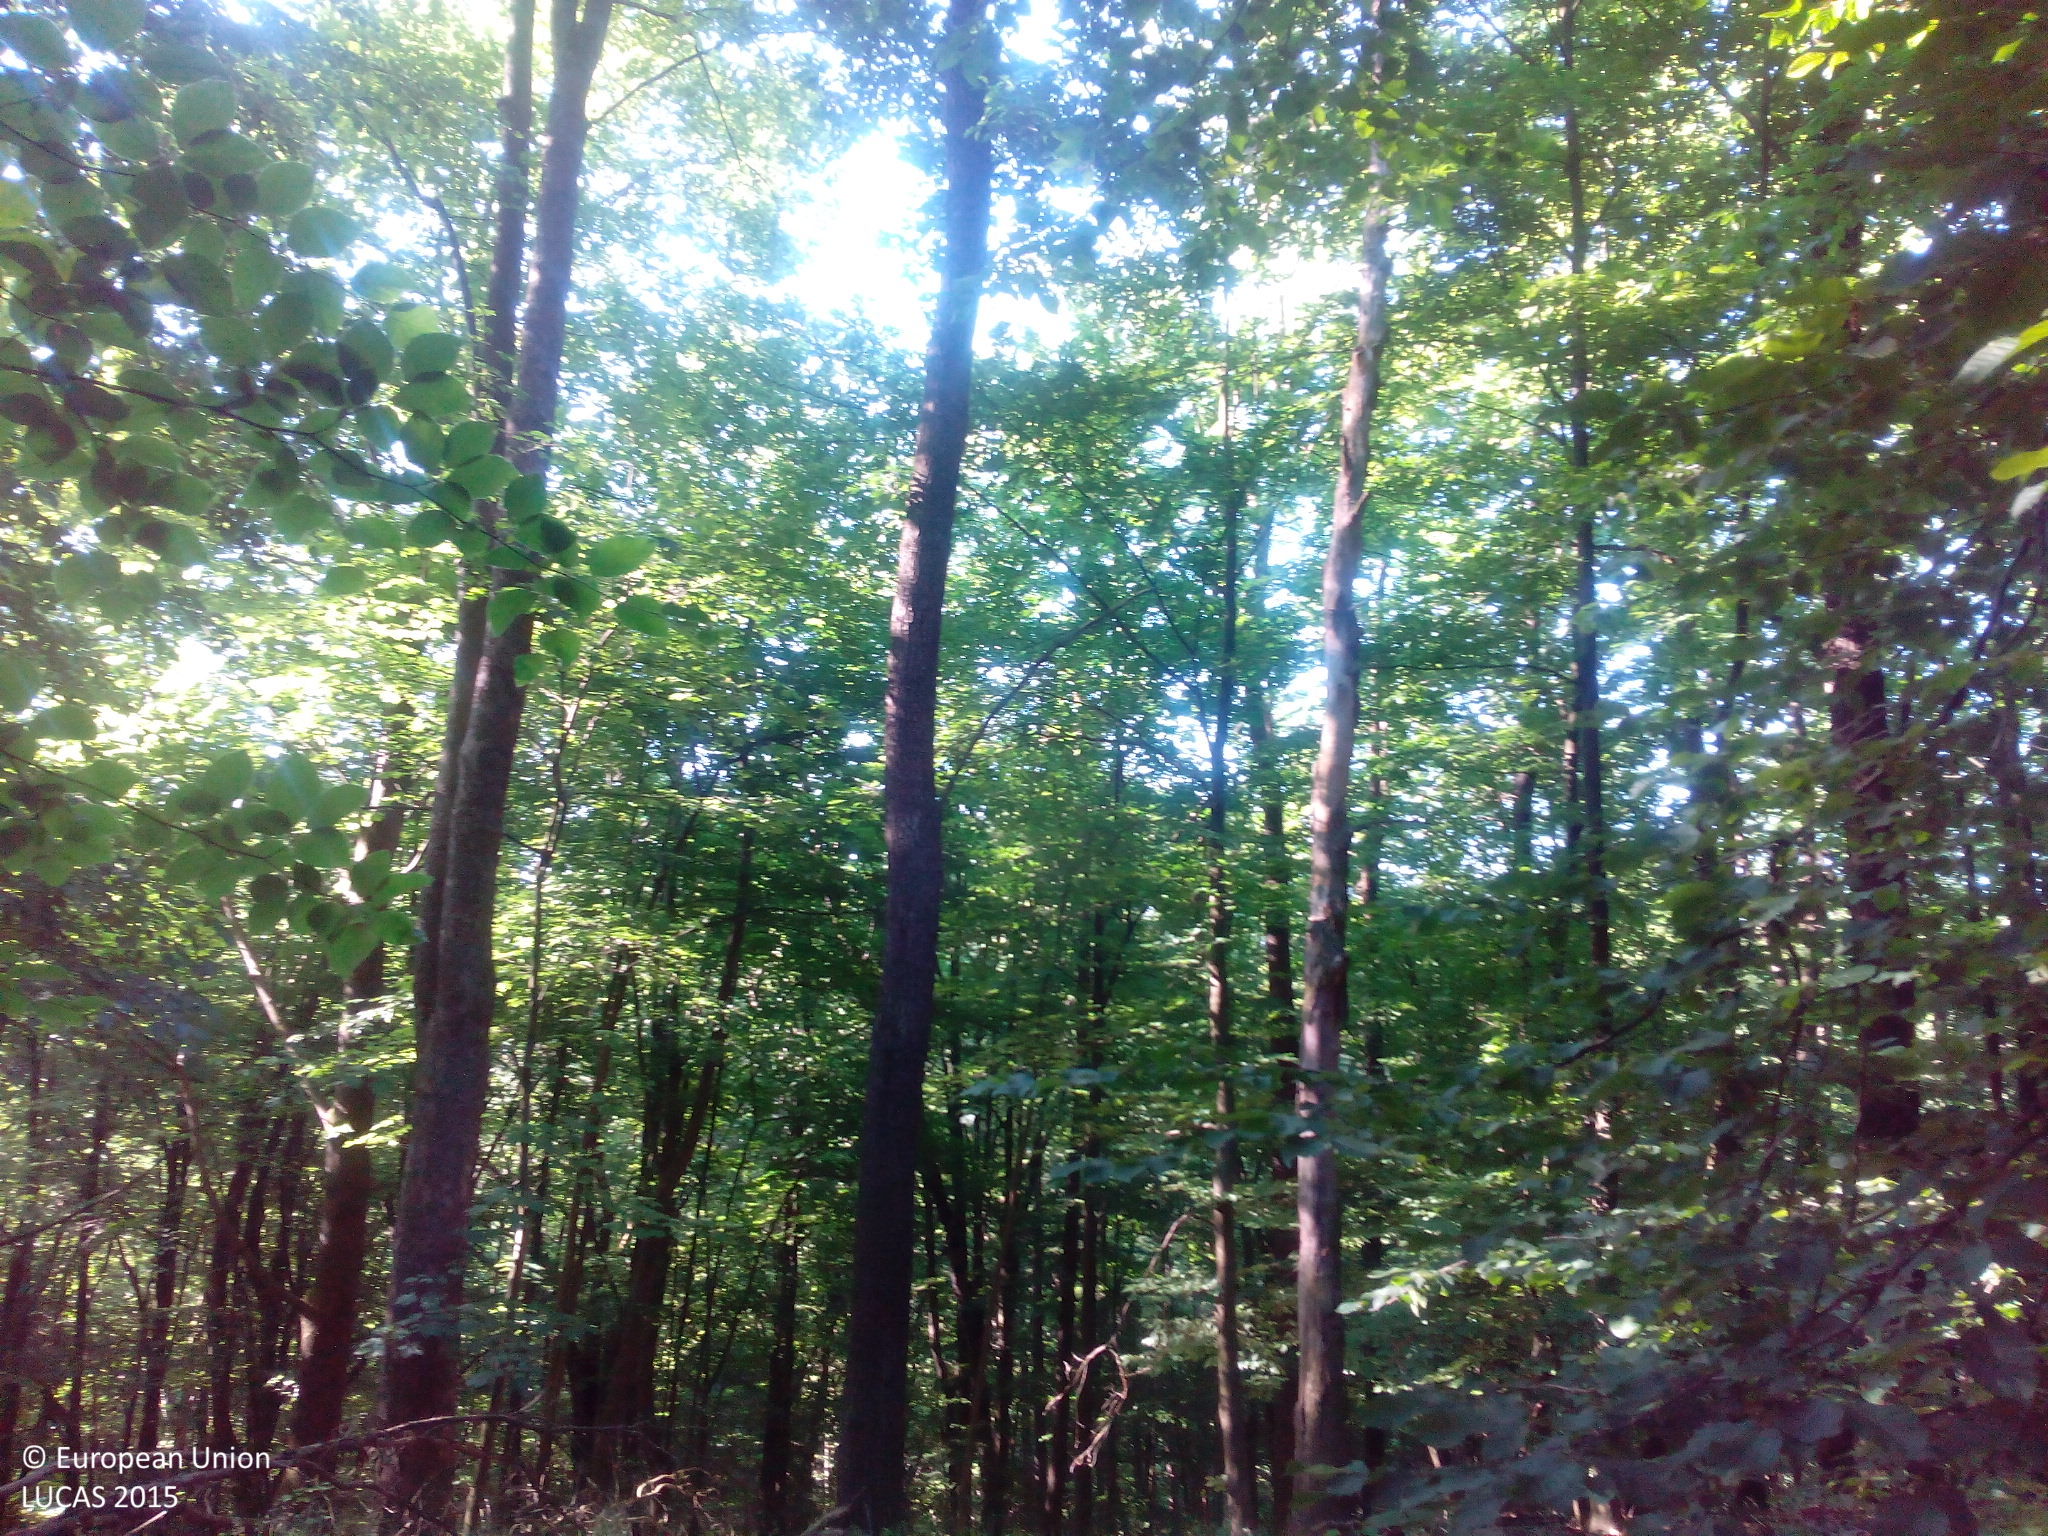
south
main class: Woodland
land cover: Broadleaved woodland
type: beech forest
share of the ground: > 75 %
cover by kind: broadleaved forest trees 100 %
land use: Forestry
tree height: > 5 m
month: June
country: DE
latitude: 50.9357
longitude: 13.0310
